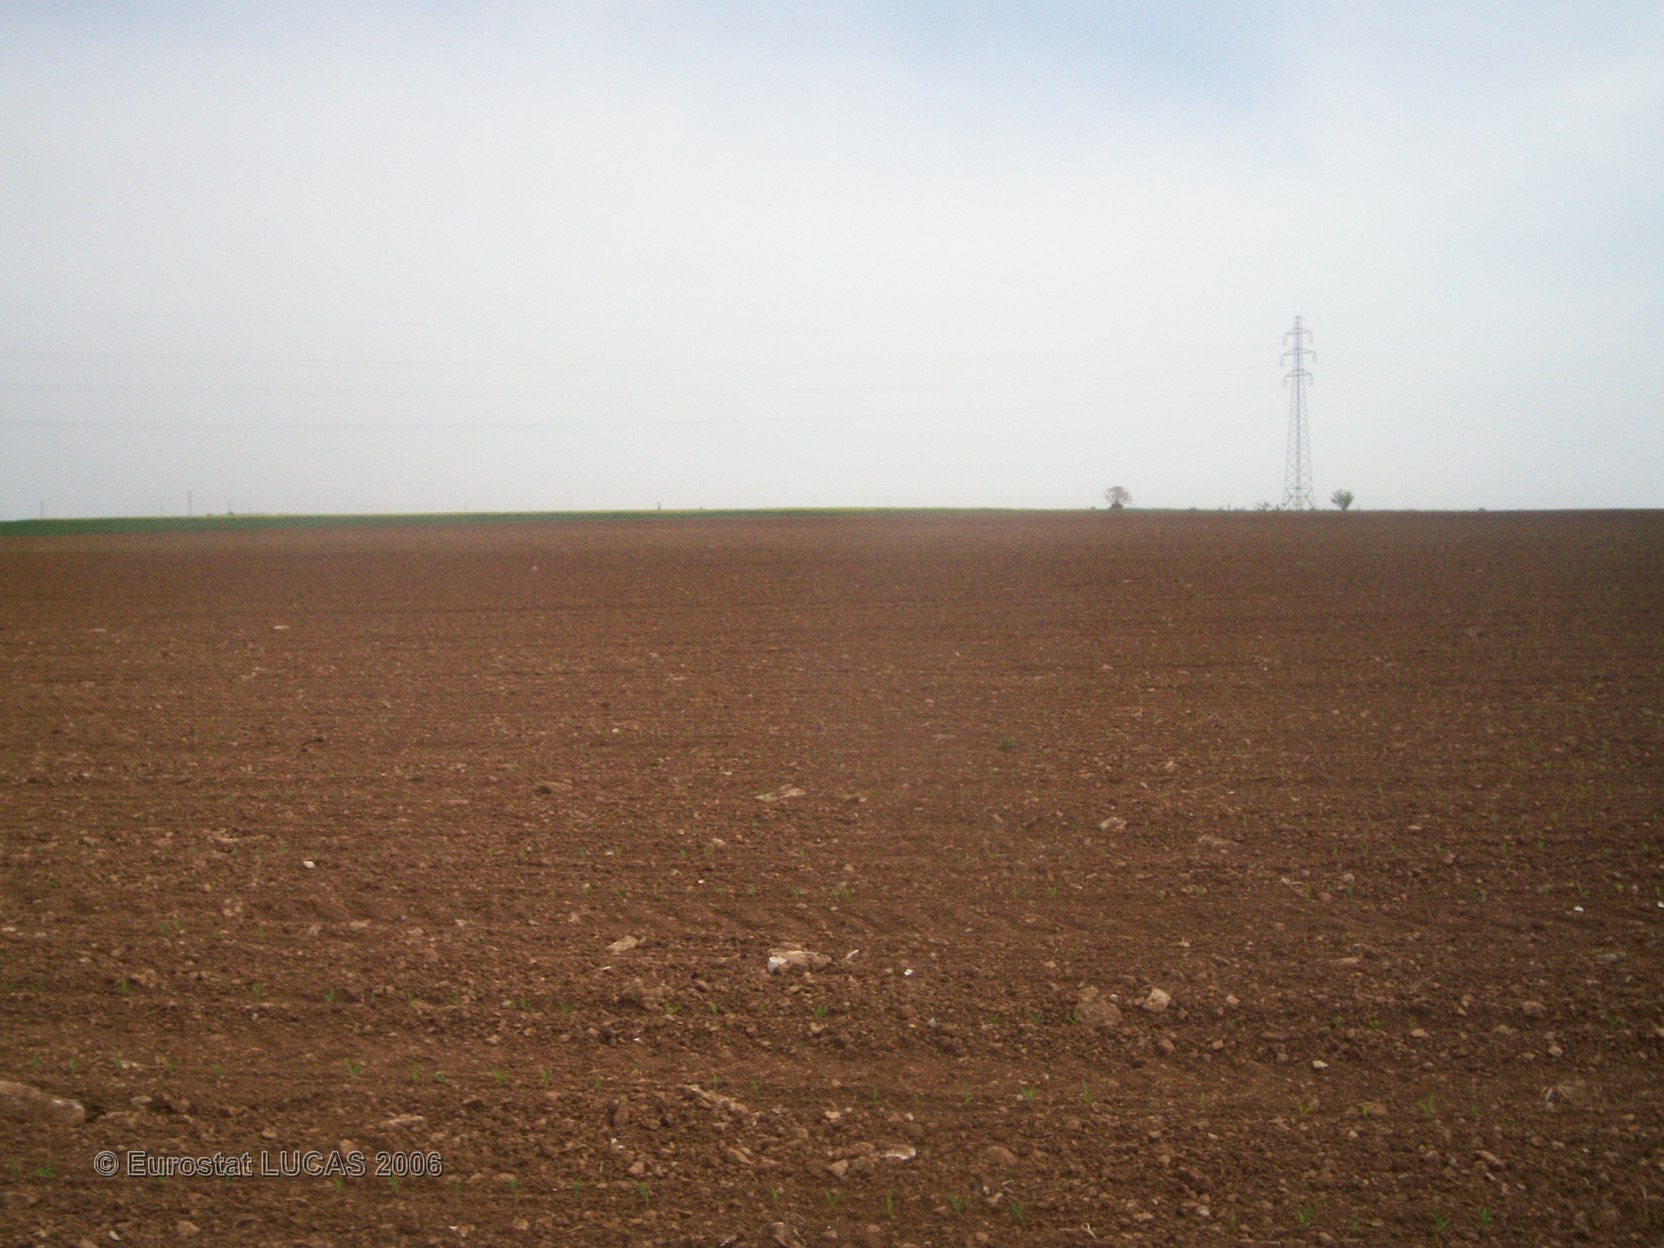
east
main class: Cropland
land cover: Maize
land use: Agriculture (excluding fallow land and kitchen gardens)
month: May
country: FR
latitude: 46.4741
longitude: -0.9848
